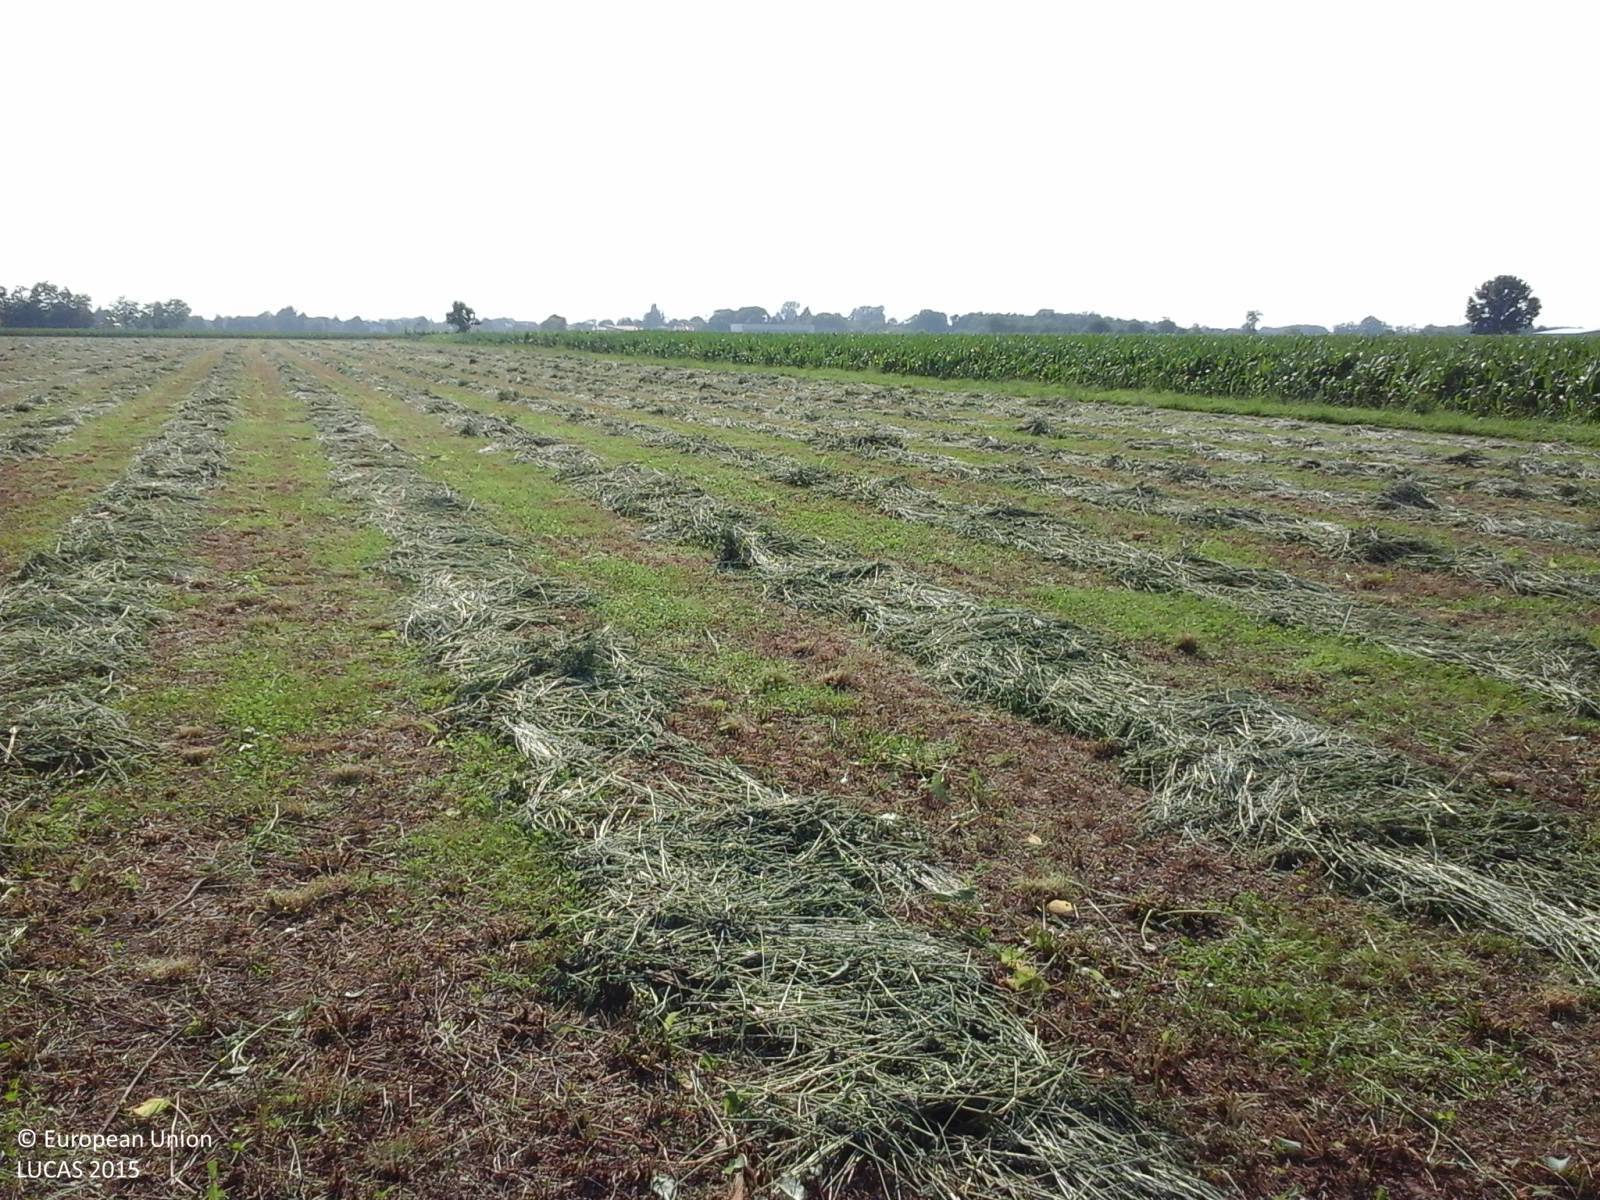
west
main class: Cropland
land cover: Lucerne
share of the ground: > 75 %
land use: Agriculture (excluding fallow land and kitchen gardens)
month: June
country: IT
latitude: 45.9214
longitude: 13.3100
